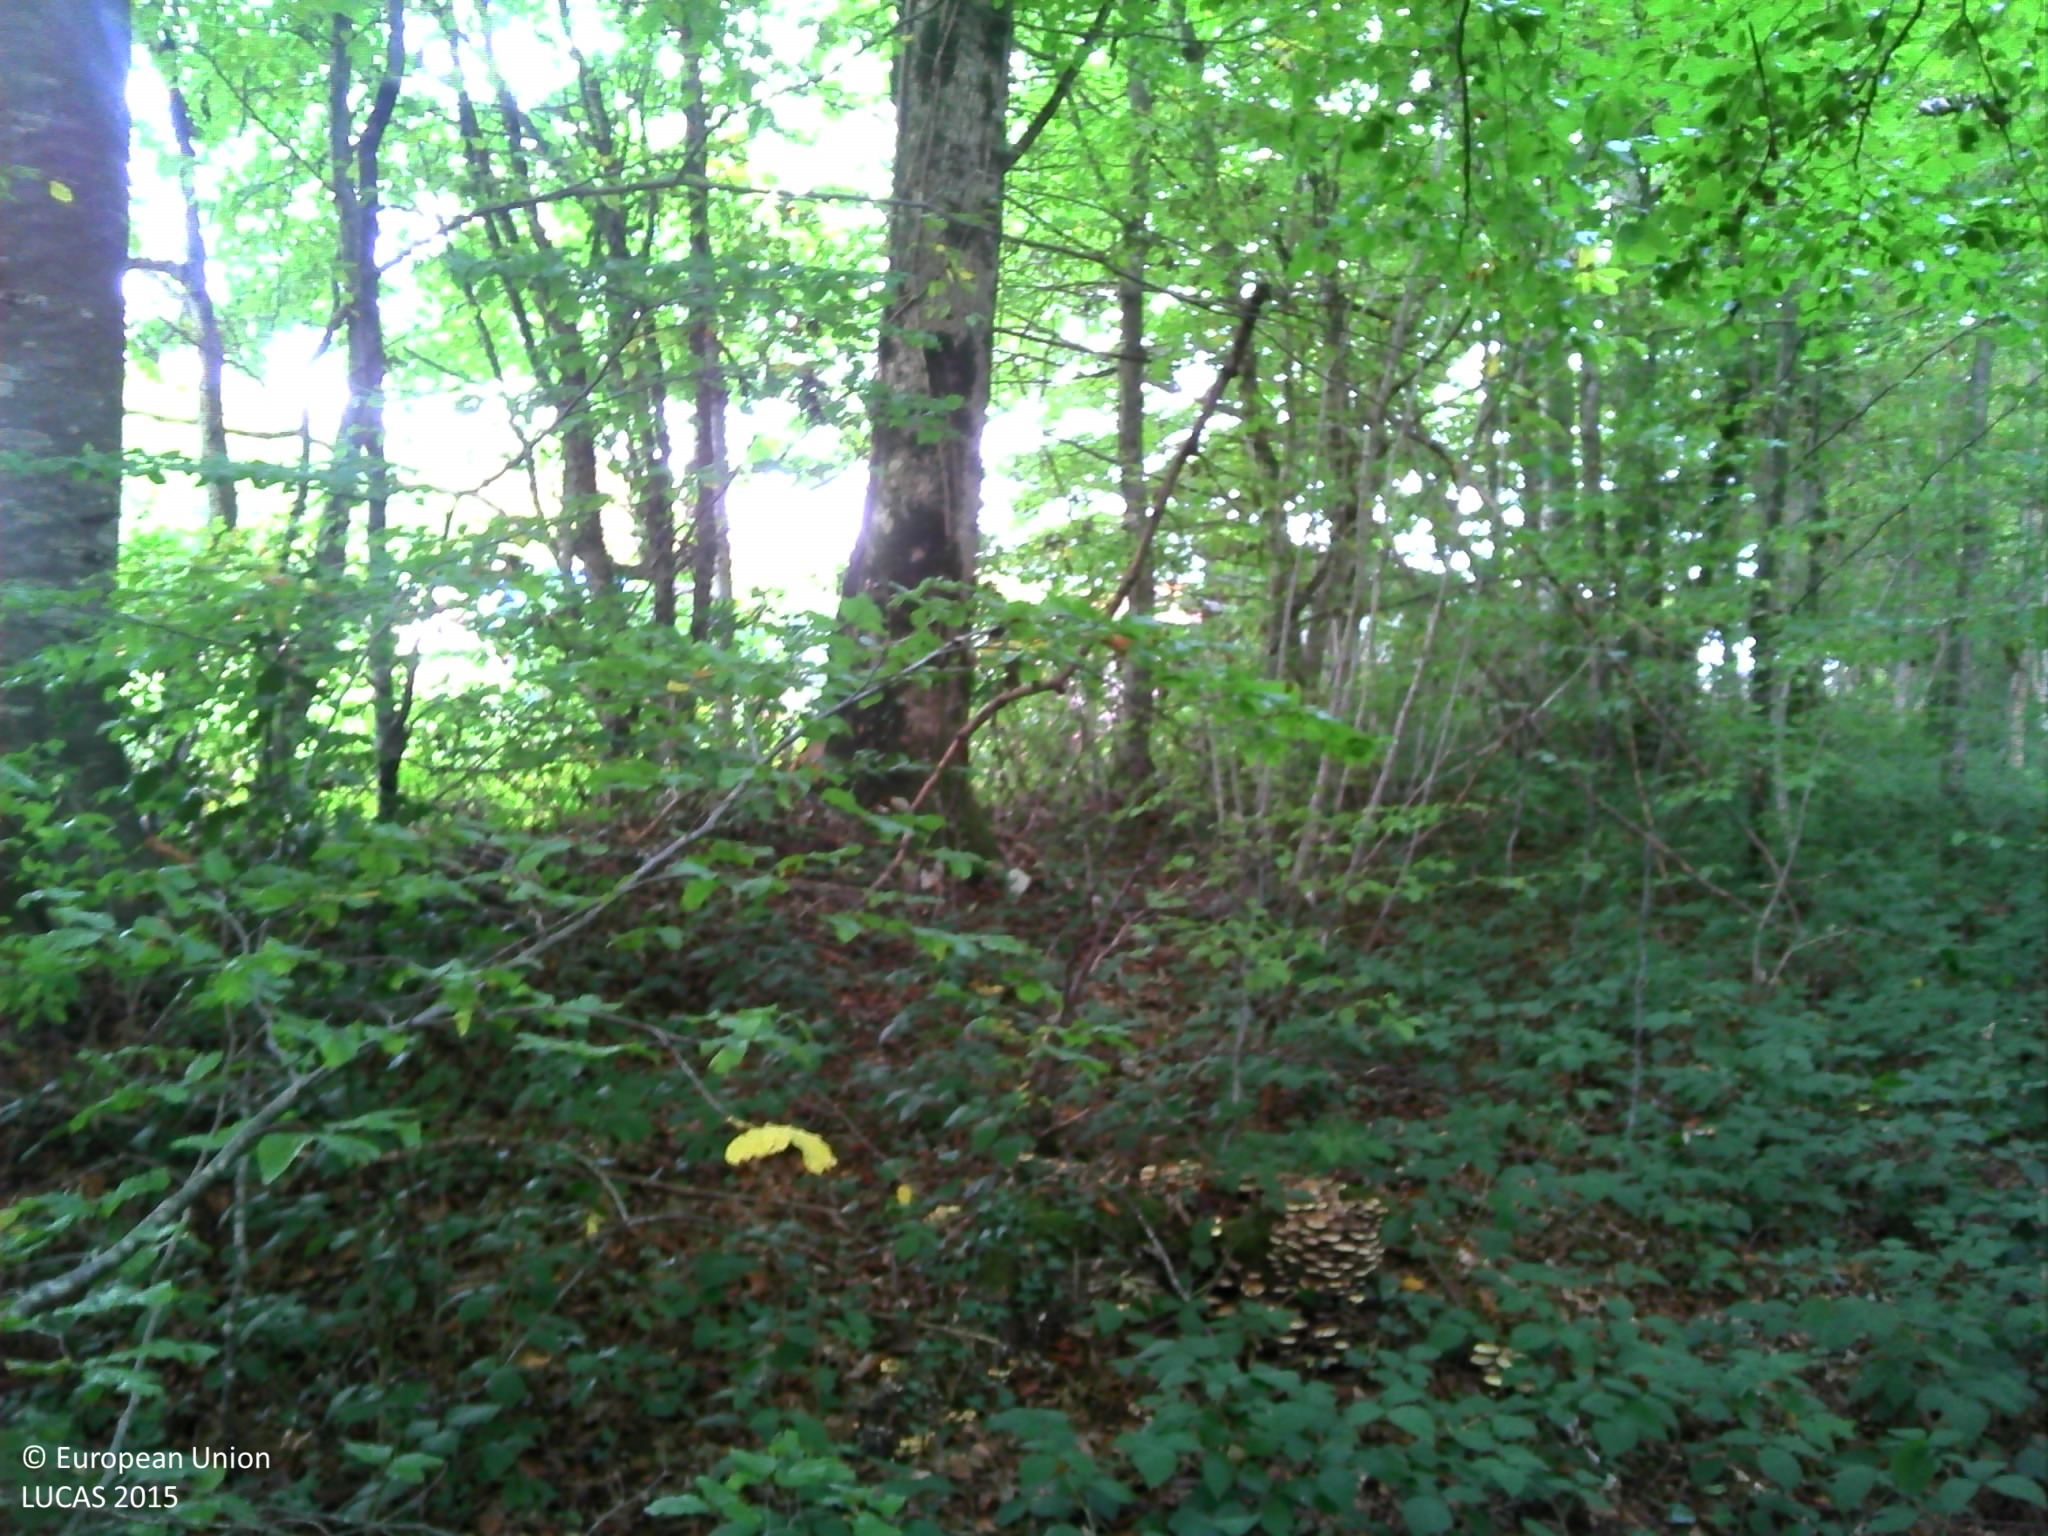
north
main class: Woodland
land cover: Broadleaved woodland
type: beech forest
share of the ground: > 75 %
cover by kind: broadleaved forest trees 90 %, herbaceous plants 5 %, unconsolidated bare surface 5 %
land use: Forestry
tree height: > 5 m
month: October
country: FR
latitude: 47.0749
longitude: 6.1434
